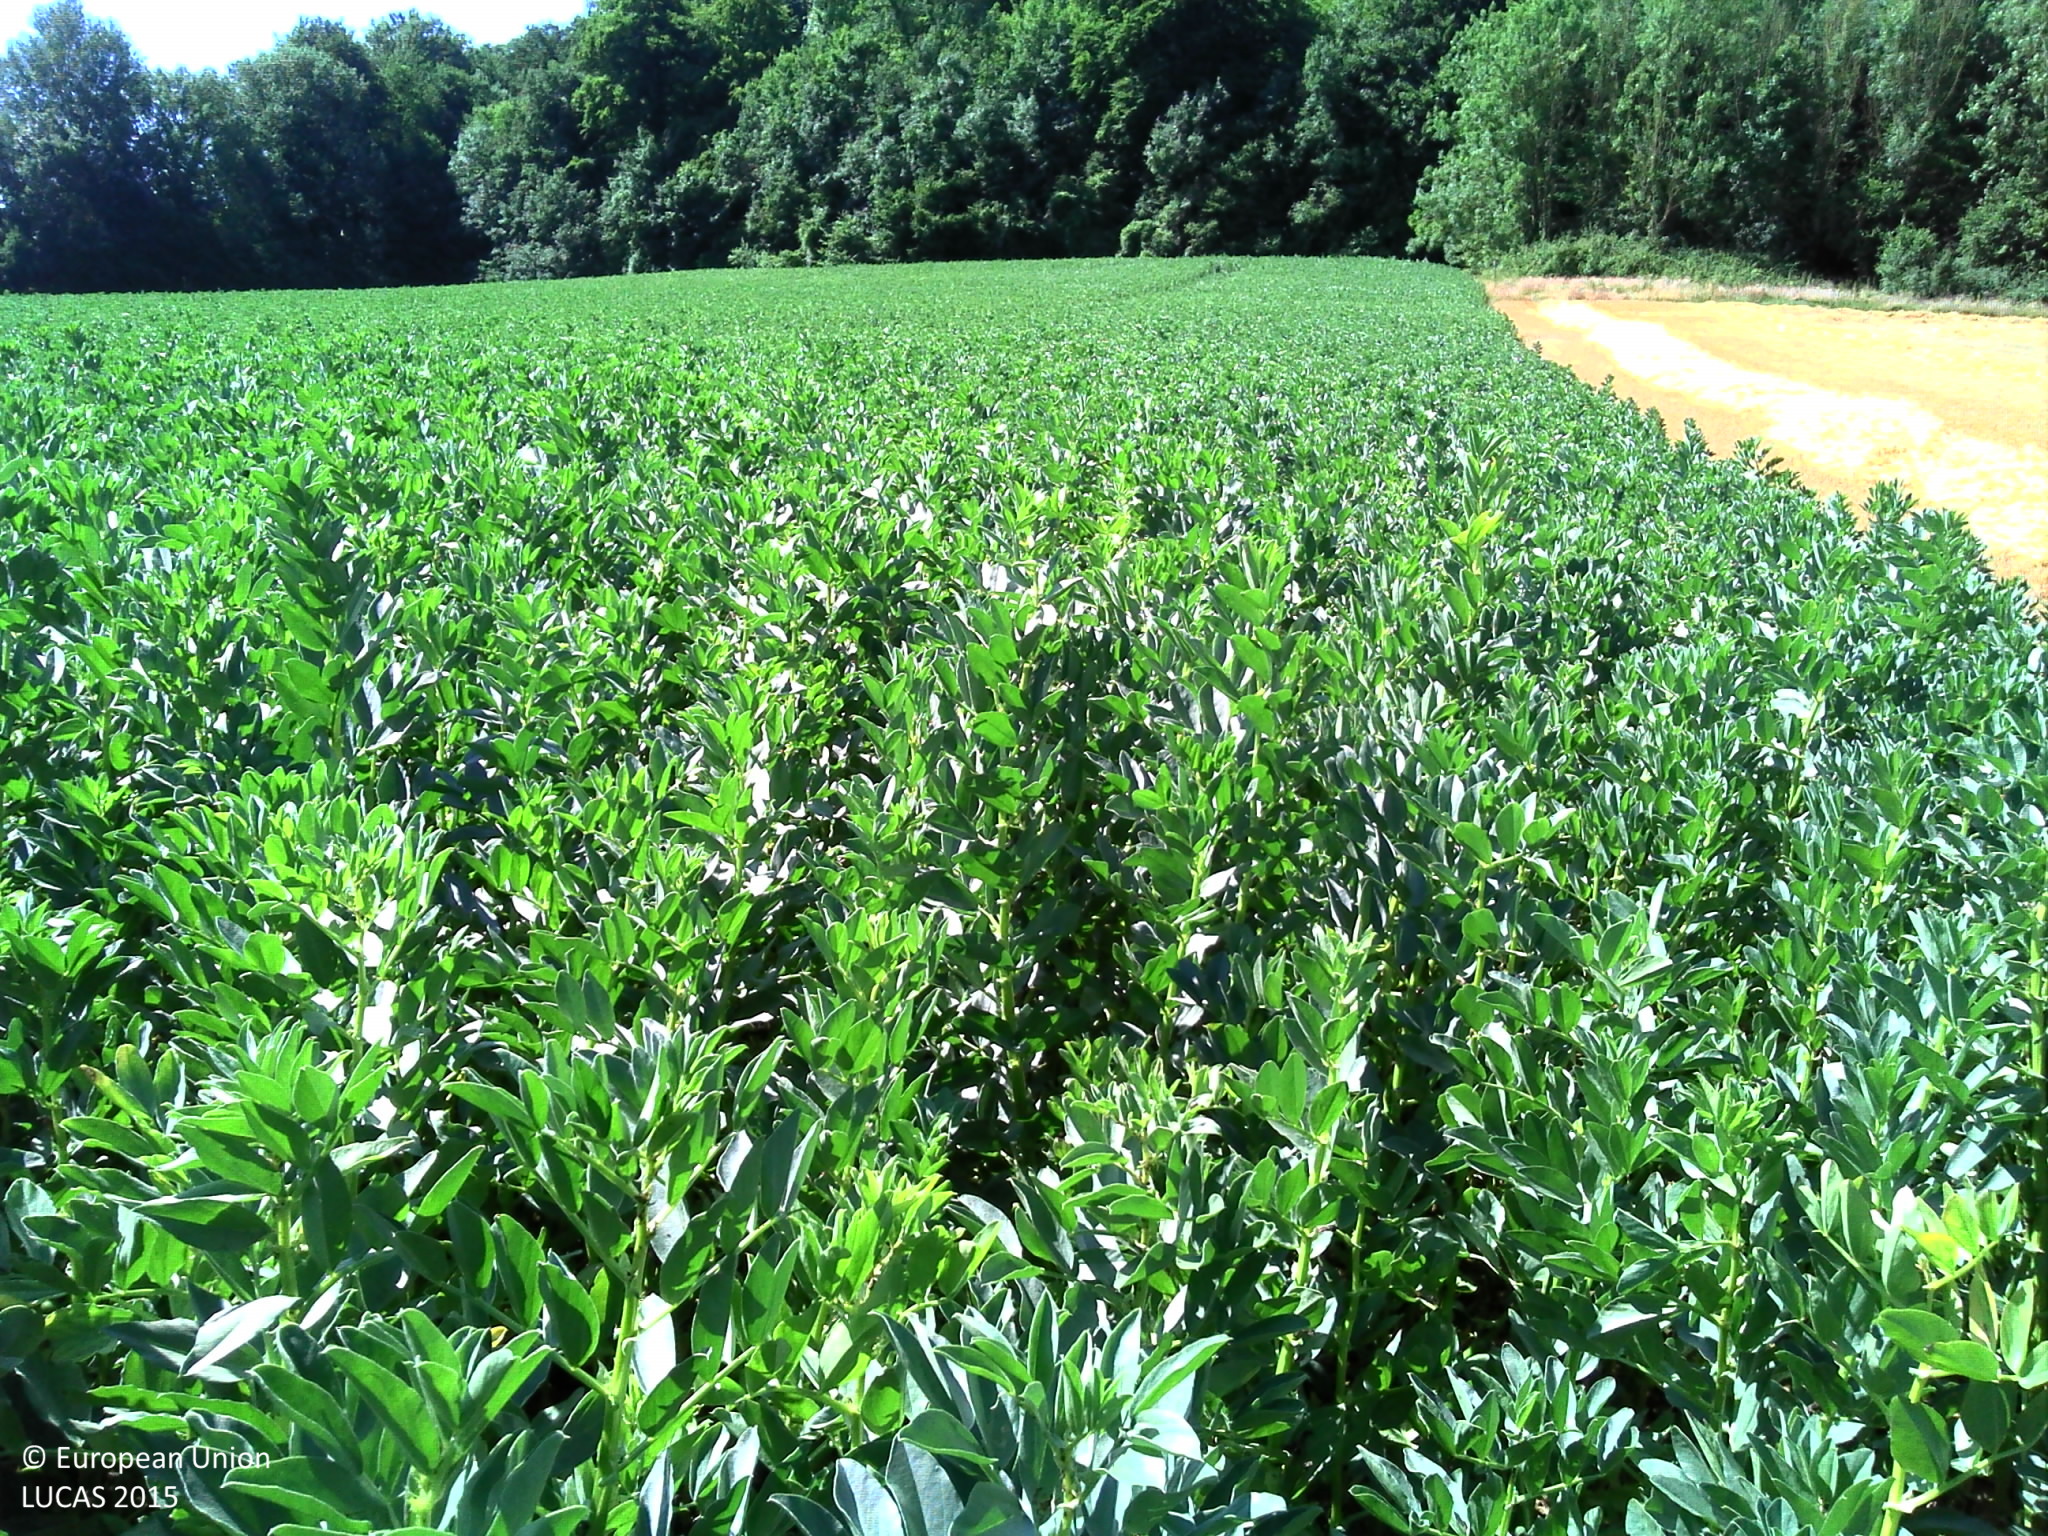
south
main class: Cropland
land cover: Dry pulses
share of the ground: > 75 %
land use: Agriculture (excluding fallow land and kitchen gardens)
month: July
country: FR
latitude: 50.2186
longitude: 2.1228
